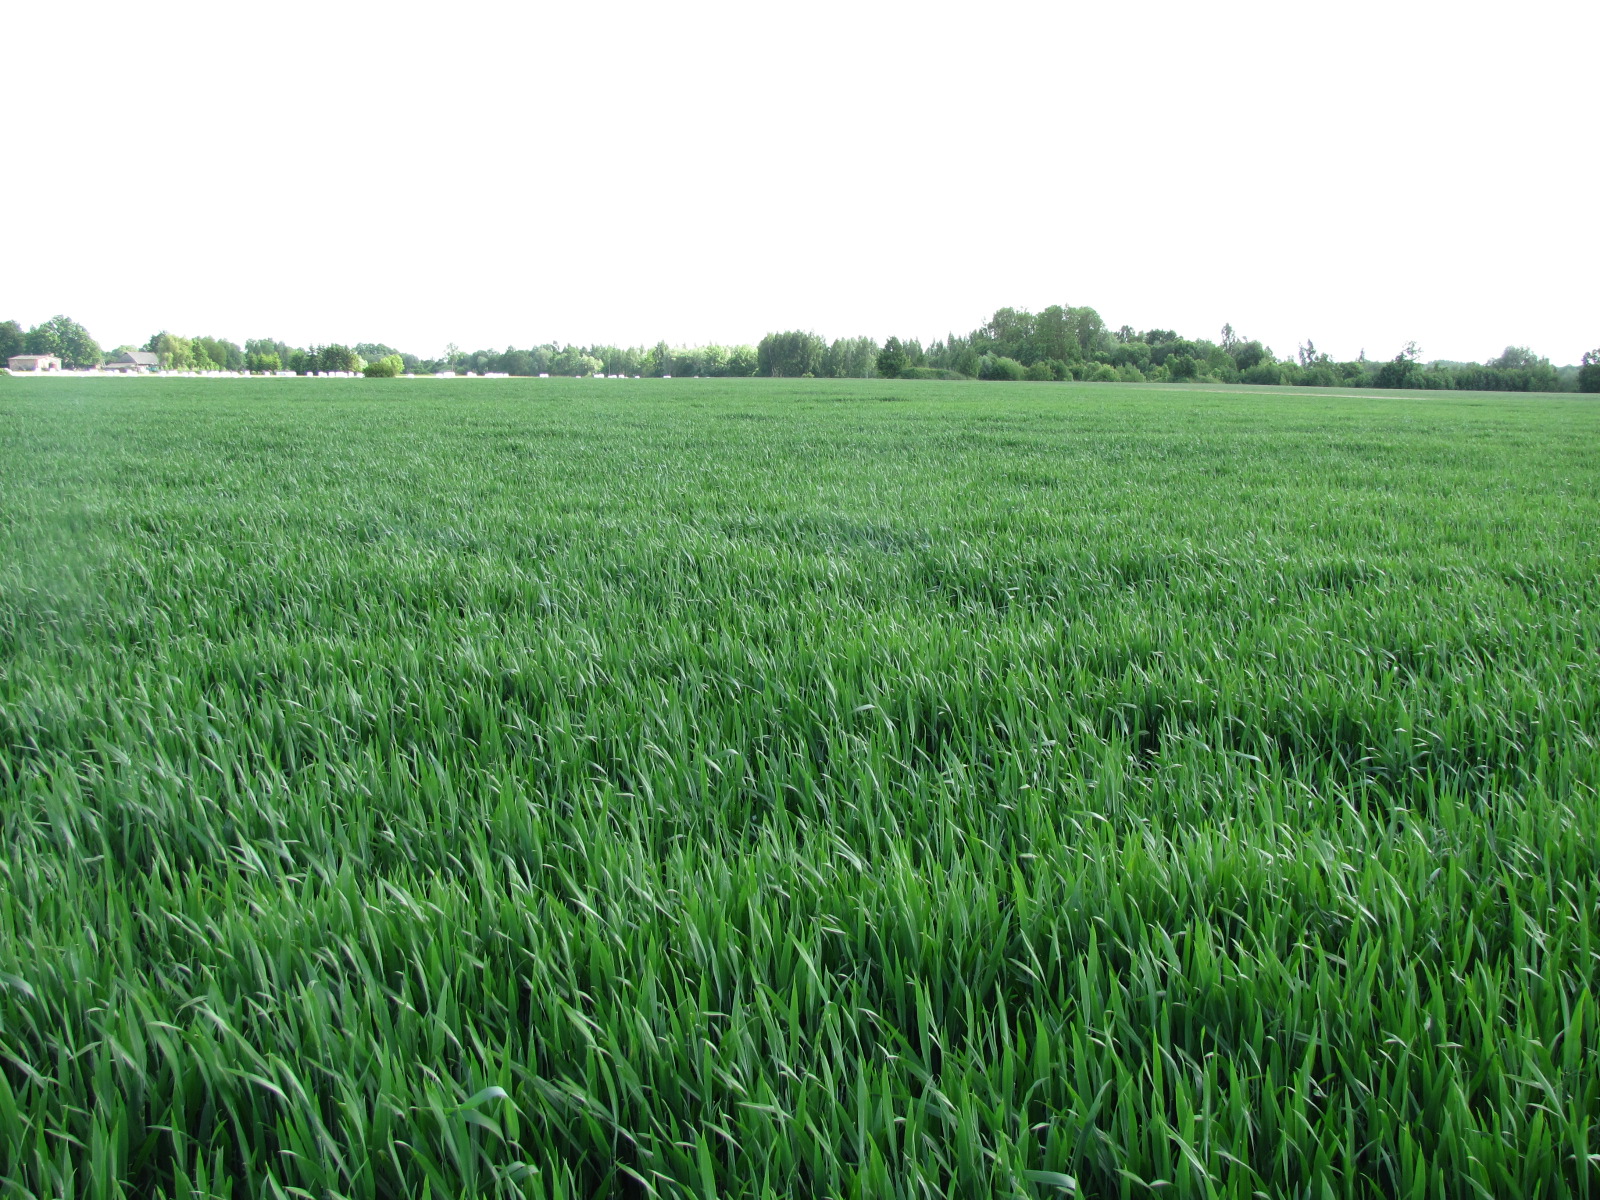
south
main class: Cropland
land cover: Common wheat
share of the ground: > 75 %
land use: Agriculture (excluding fallow land and kitchen gardens)
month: June
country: LV
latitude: 56.3280
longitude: 24.1756
